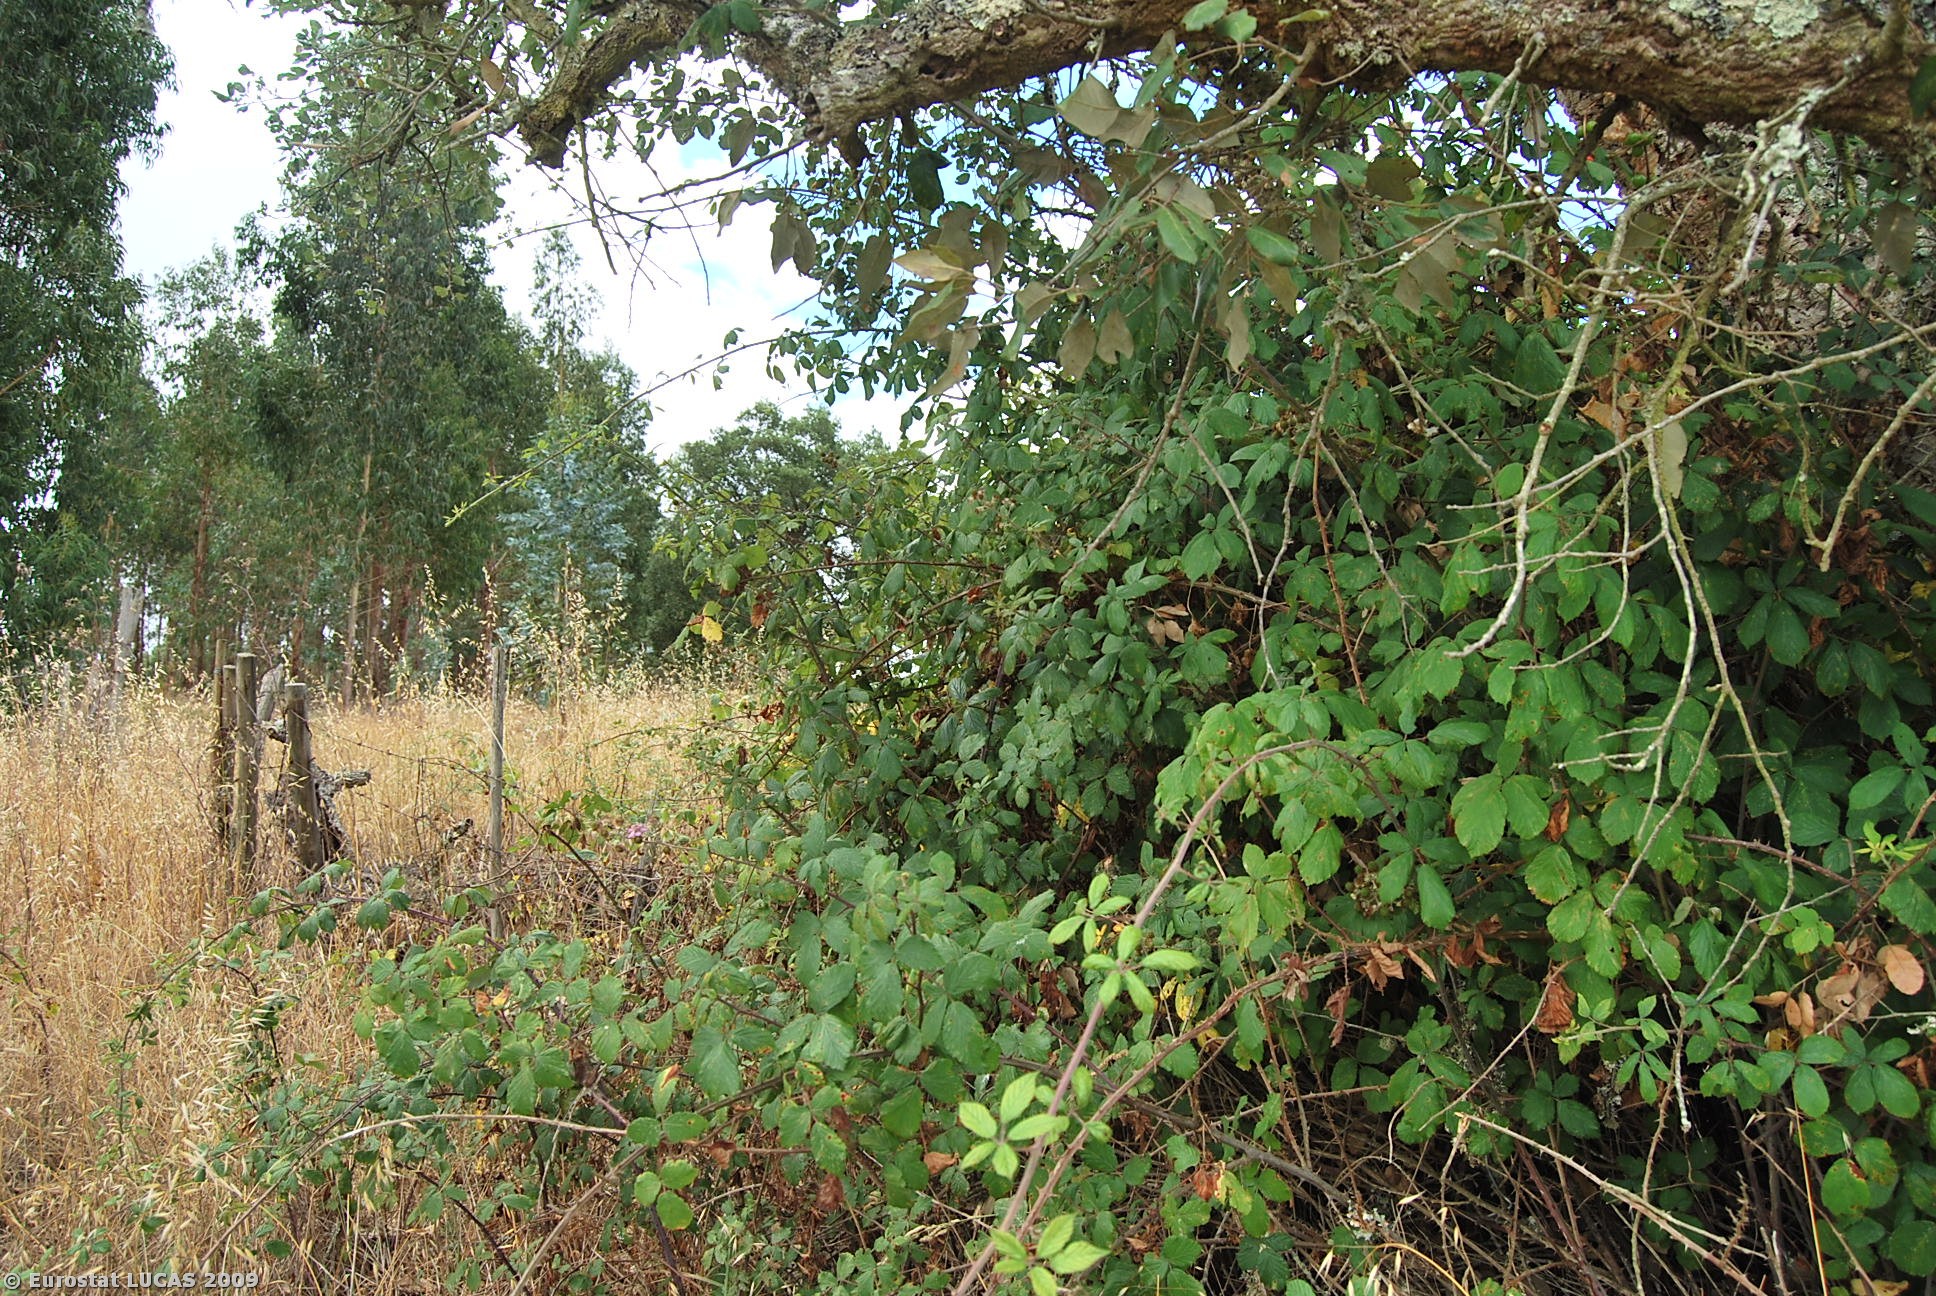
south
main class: Shrubland
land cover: Shrubland with sparse tree cover
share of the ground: 50 - 75 %
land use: Nature reserves
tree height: > 5 m
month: June
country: PT
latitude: 37.7406
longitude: -8.6406
